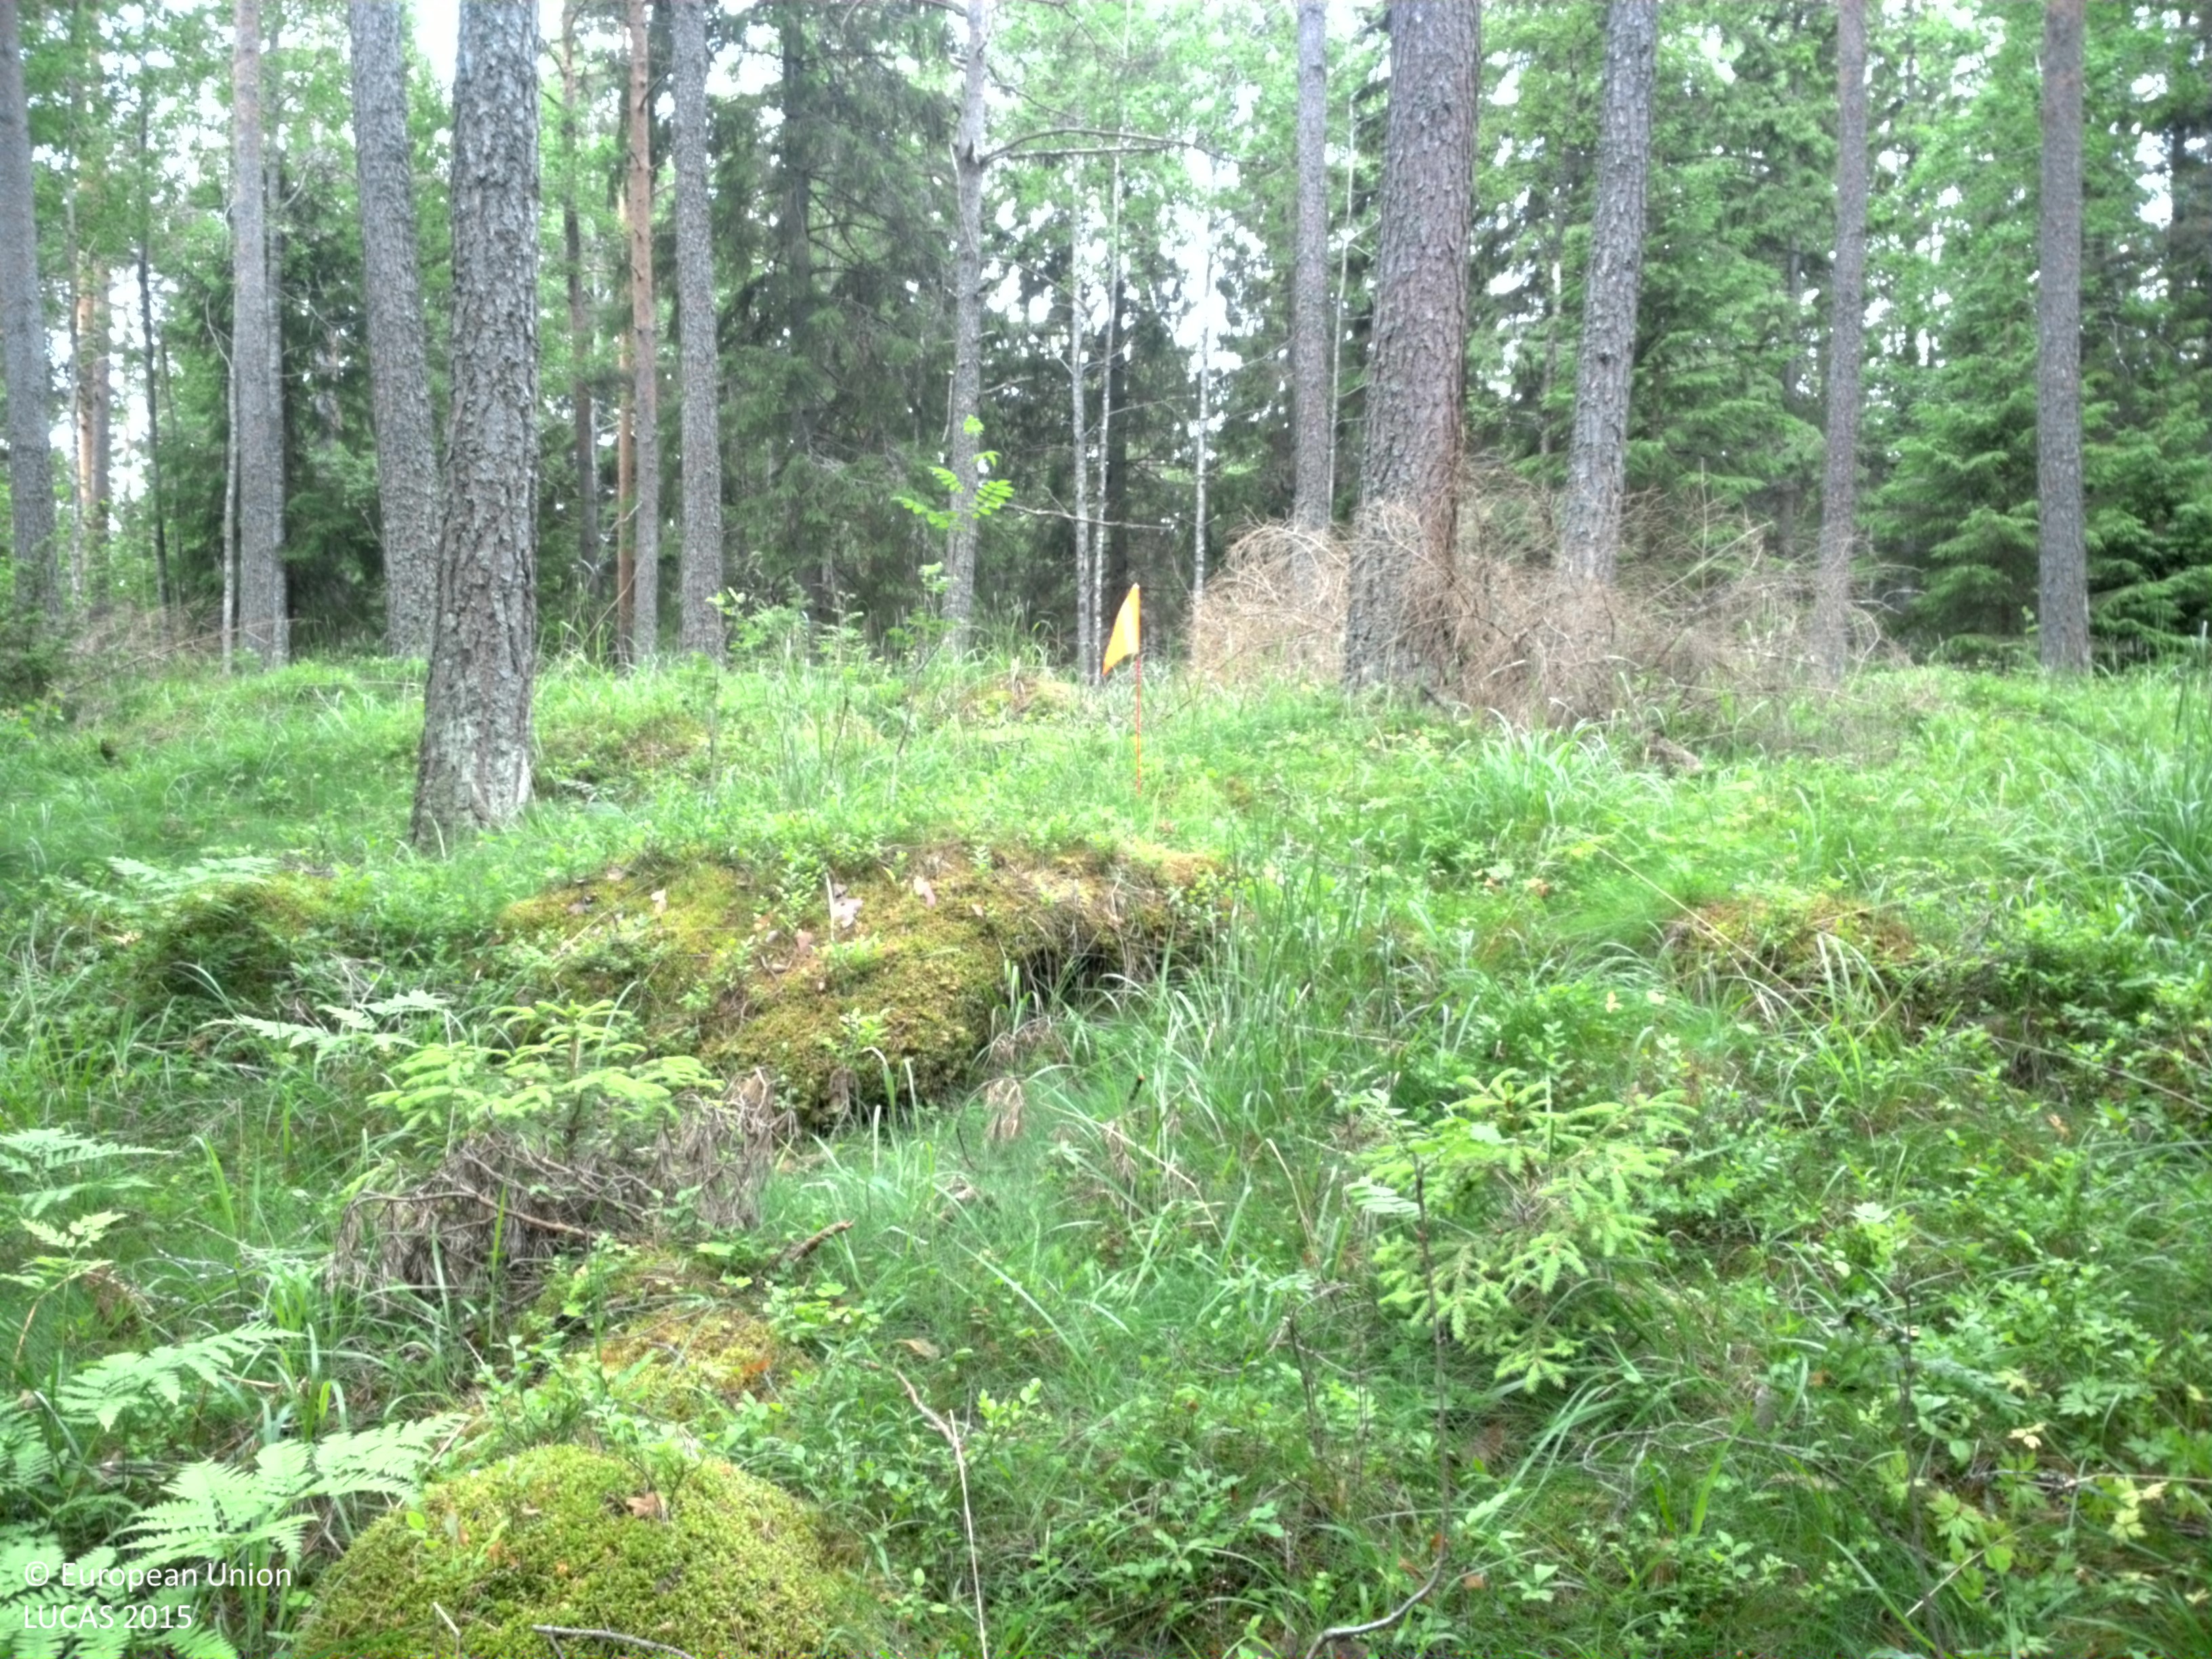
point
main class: Woodland
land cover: Other coniferous woodland
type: boreal forest
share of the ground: 50 - 75 %
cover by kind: coniferous forest trees 55 %, herbaceous plants 20 %, lichens and mosses 20 %, broadleaved forest trees 5 %
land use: Forestry
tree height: > 5 m
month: June
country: SE
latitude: 59.7105
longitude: 18.7280
